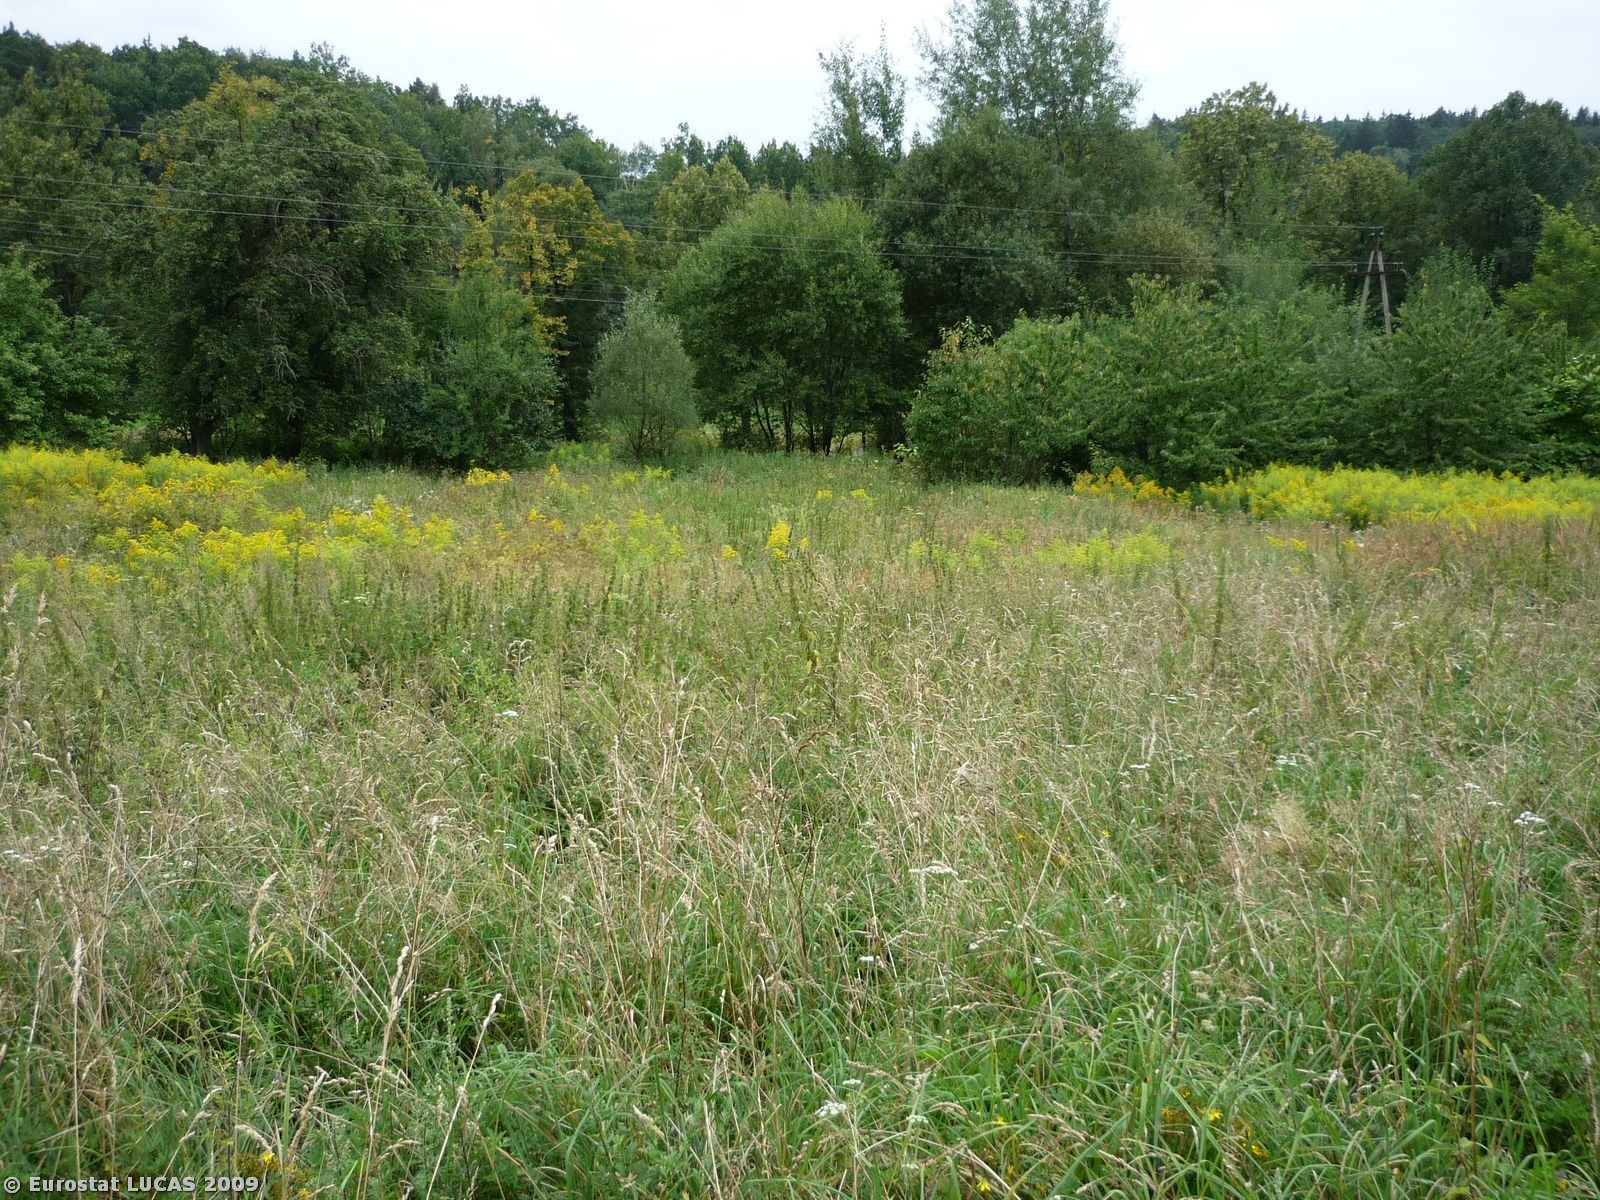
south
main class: Grassland
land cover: Grassland with sparse tree/shrub cover
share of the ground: > 75 %
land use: Nature reserves
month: August
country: PL
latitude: 50.9952
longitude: 16.0902
